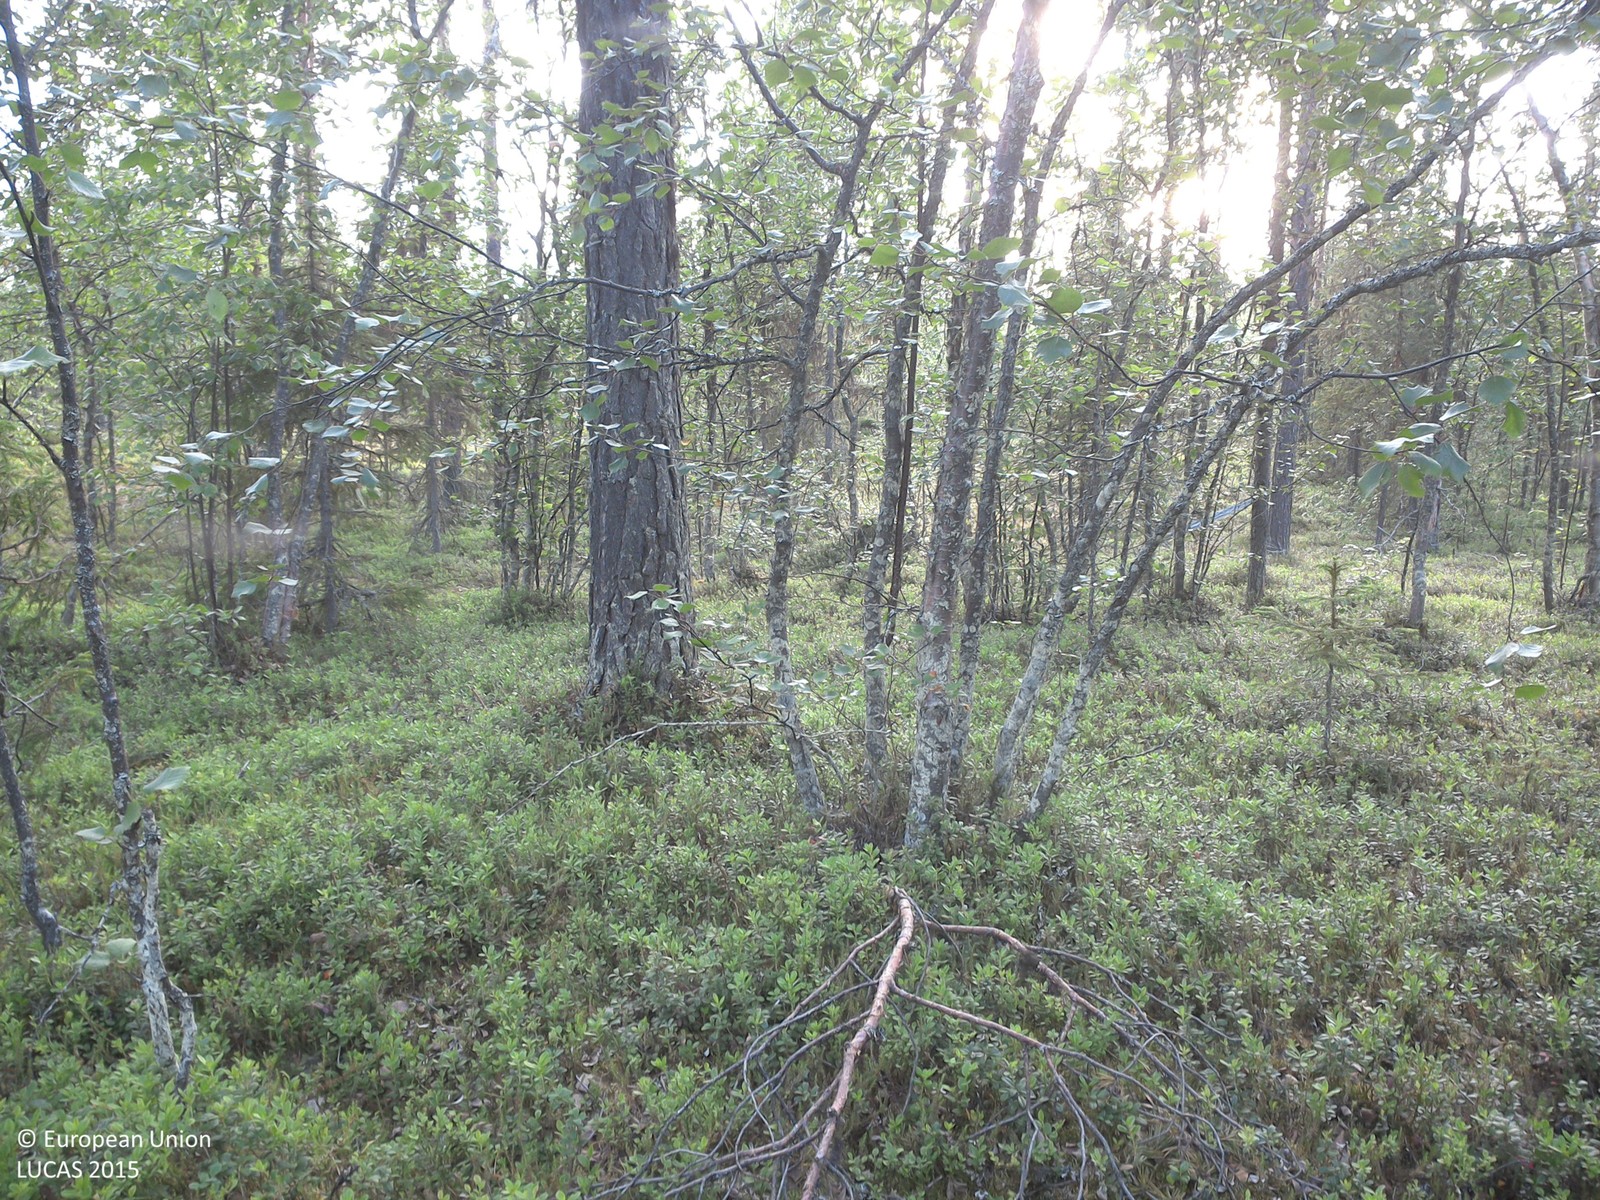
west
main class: Woodland
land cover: Pine dominated mixed woodland
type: boreal forest
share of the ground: 25 - 50 %
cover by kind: shrubs 60 %, coniferous forest trees 25 %, broadleaved forest trees 10 %, lichens and mosses 5 %
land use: Forestry
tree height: > 5 m
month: July
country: SE
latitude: 67.5072
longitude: 22.6784
